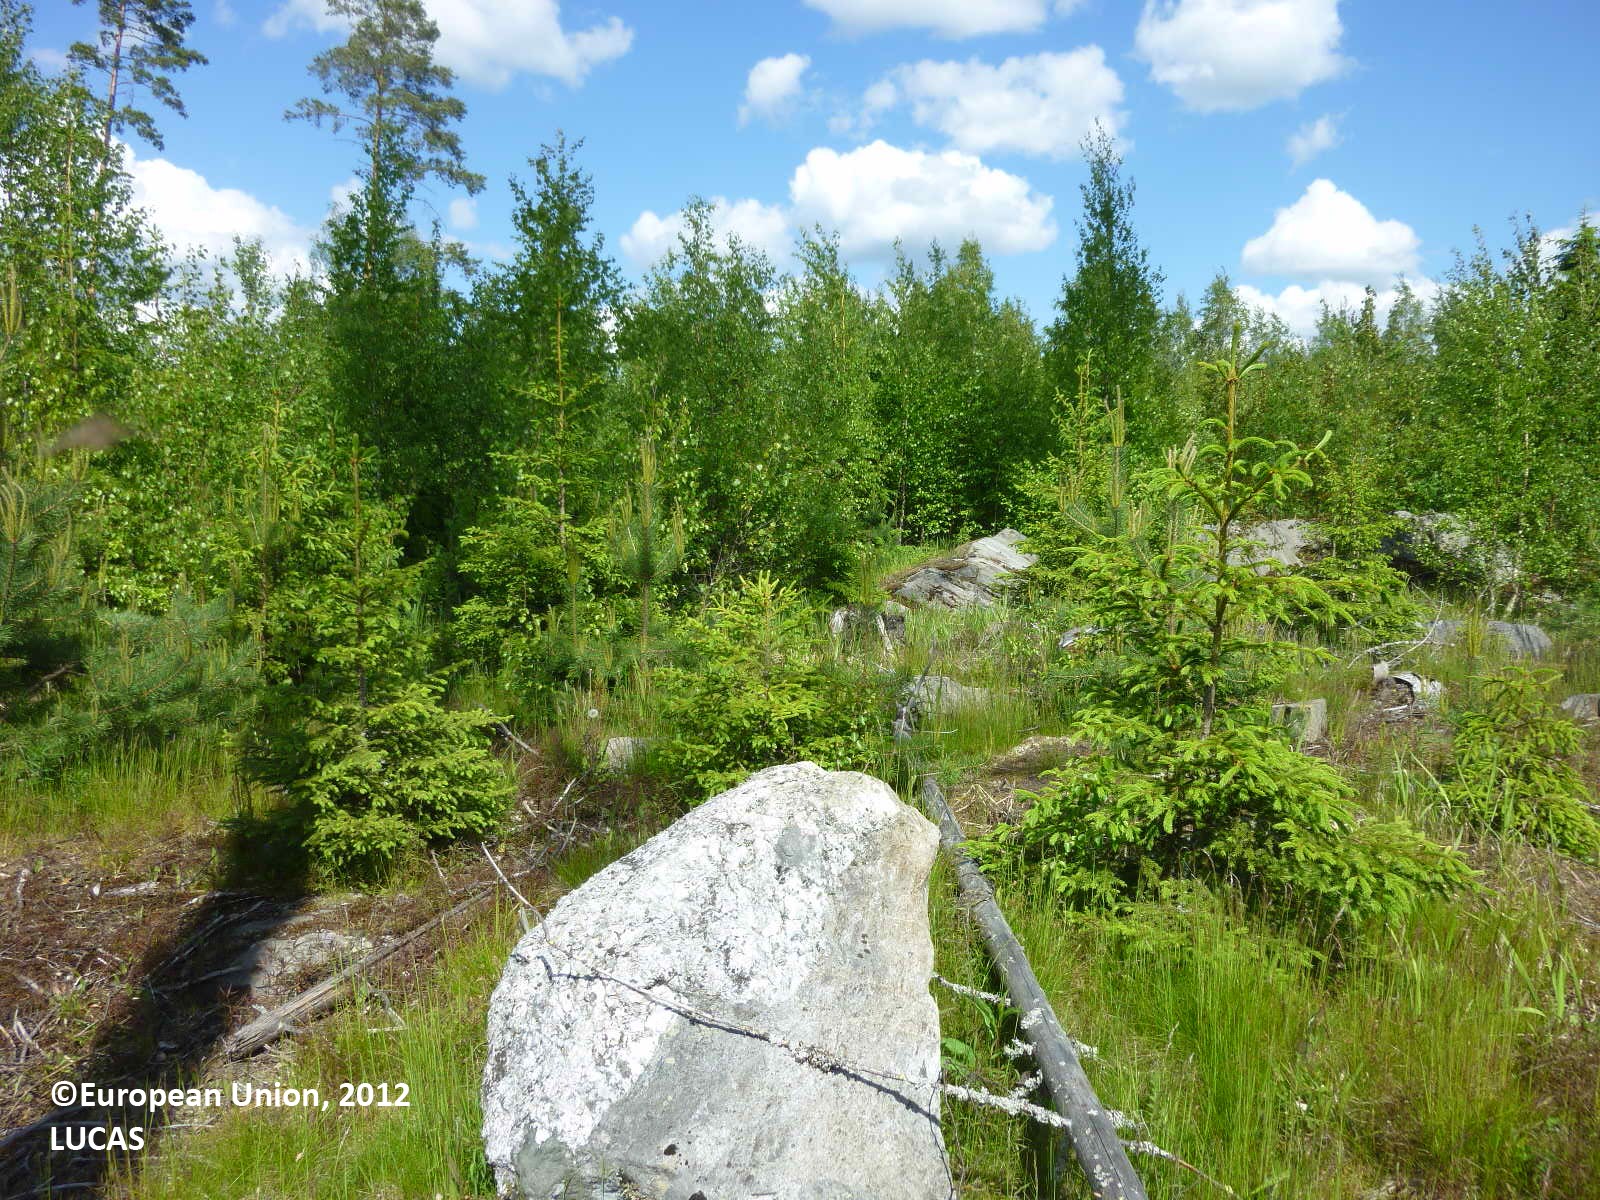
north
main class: Woodland
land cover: Broadleaved woodland
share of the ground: 25 - 50 %
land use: Forestry
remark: Clear cut
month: June
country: FI
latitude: 61.4507
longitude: 22.6901
